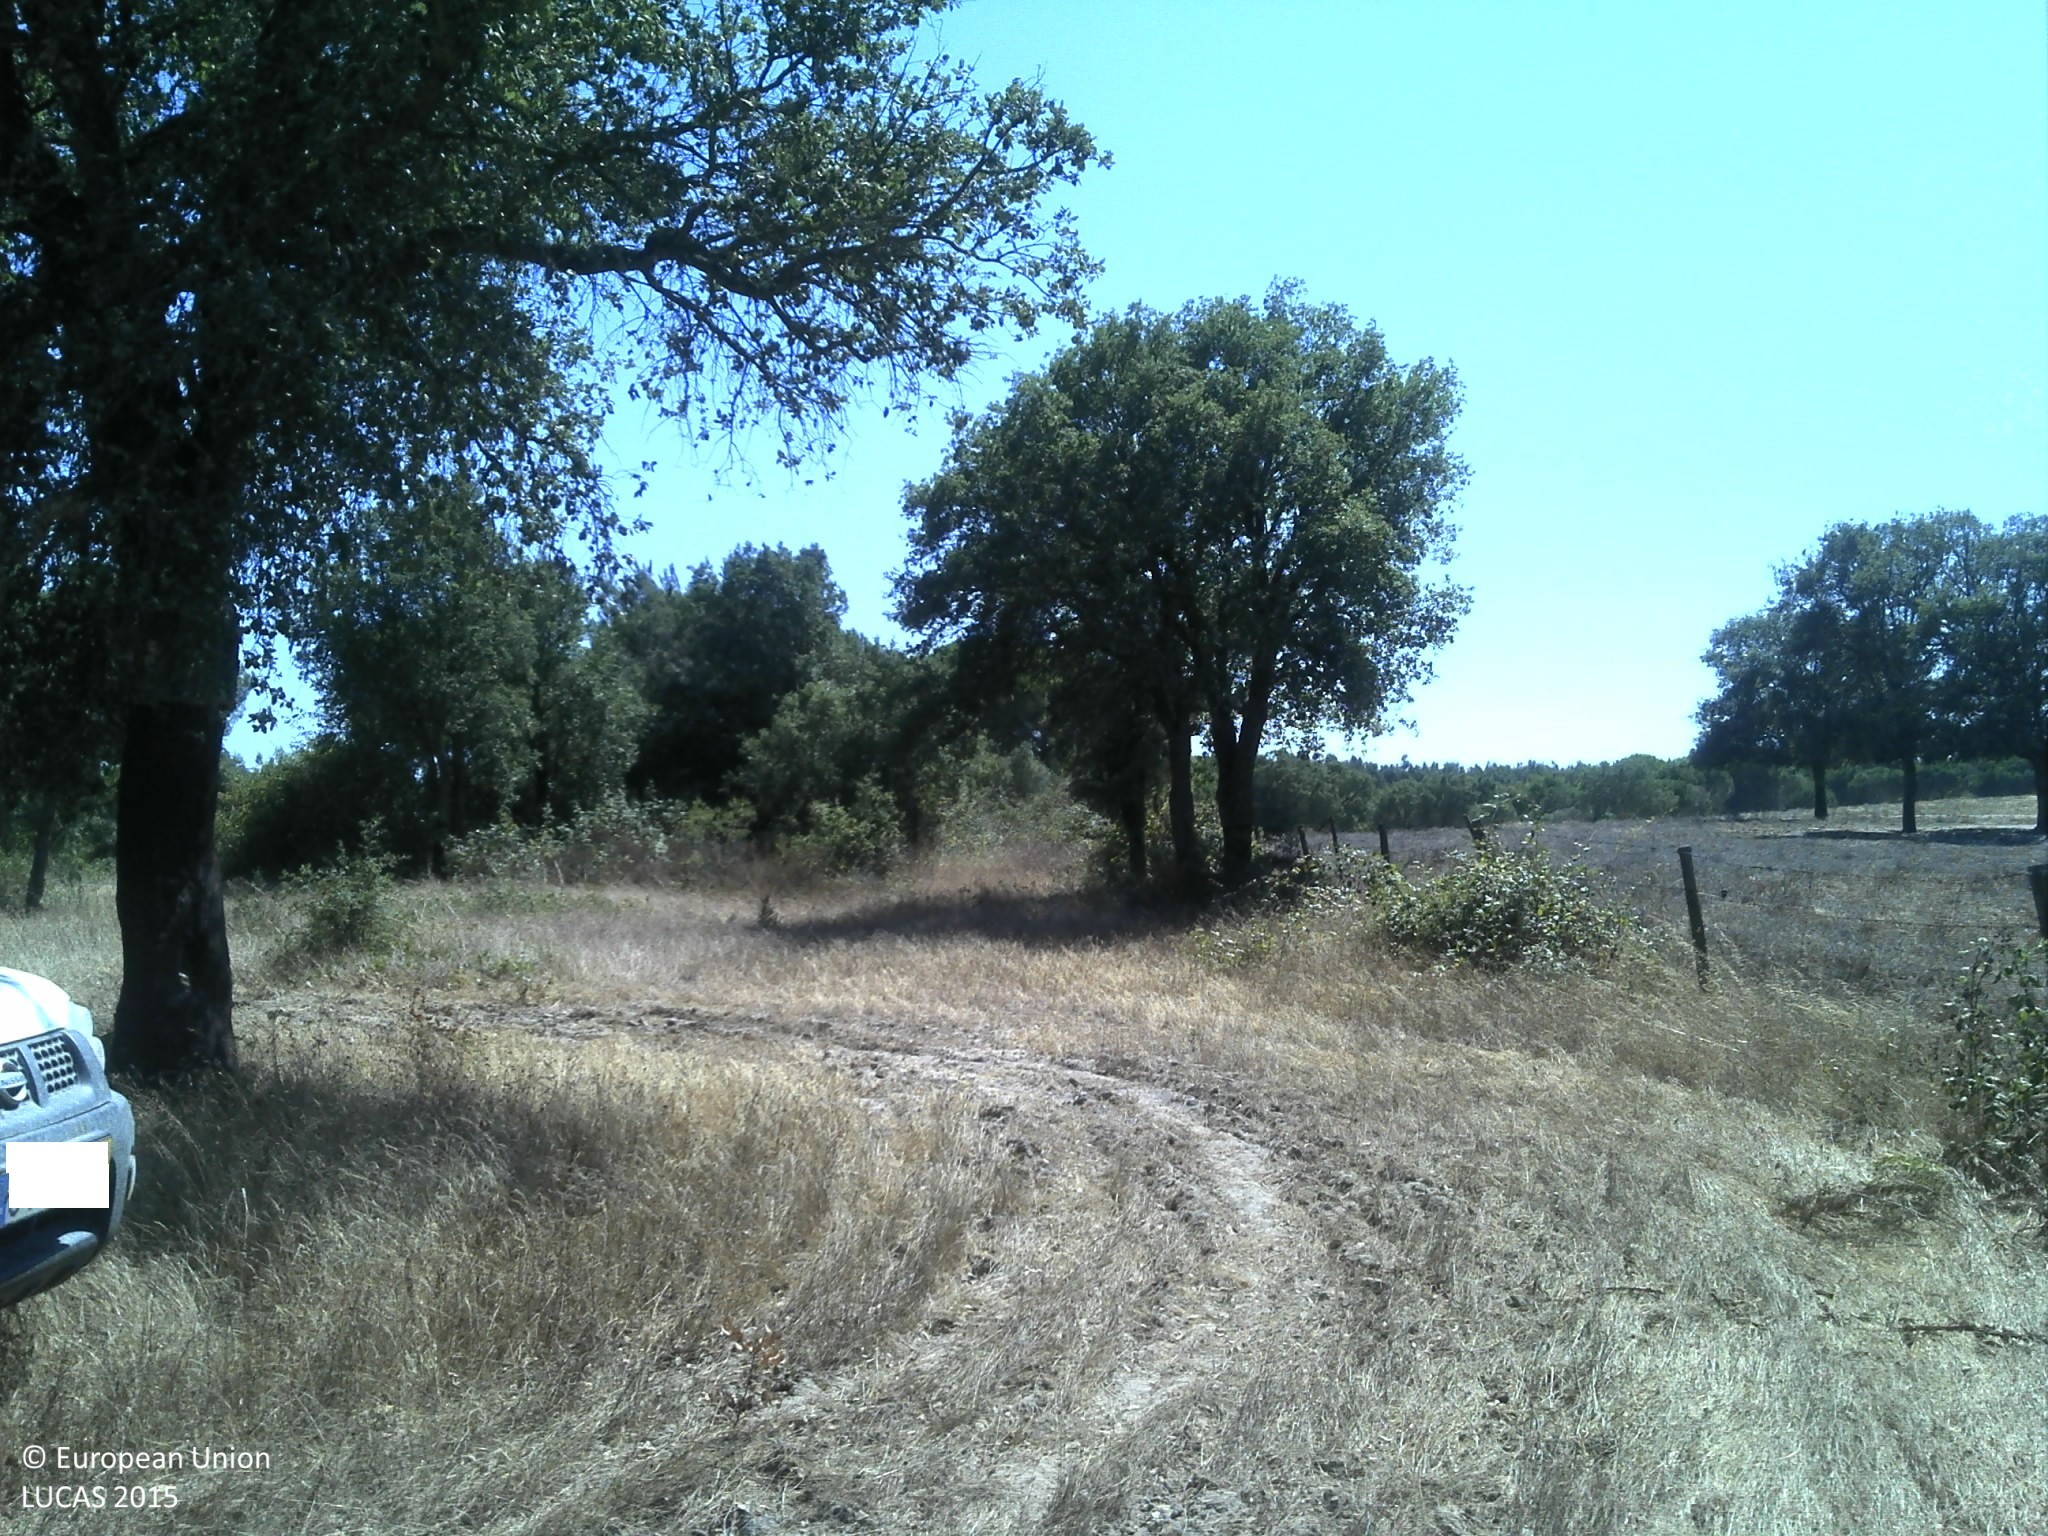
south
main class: Cropland
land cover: Temporary grasslands
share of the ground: 25 - 50 %
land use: Agriculture (excluding fallow land and kitchen gardens)
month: July
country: PT
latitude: 38.8368
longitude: -8.6222
